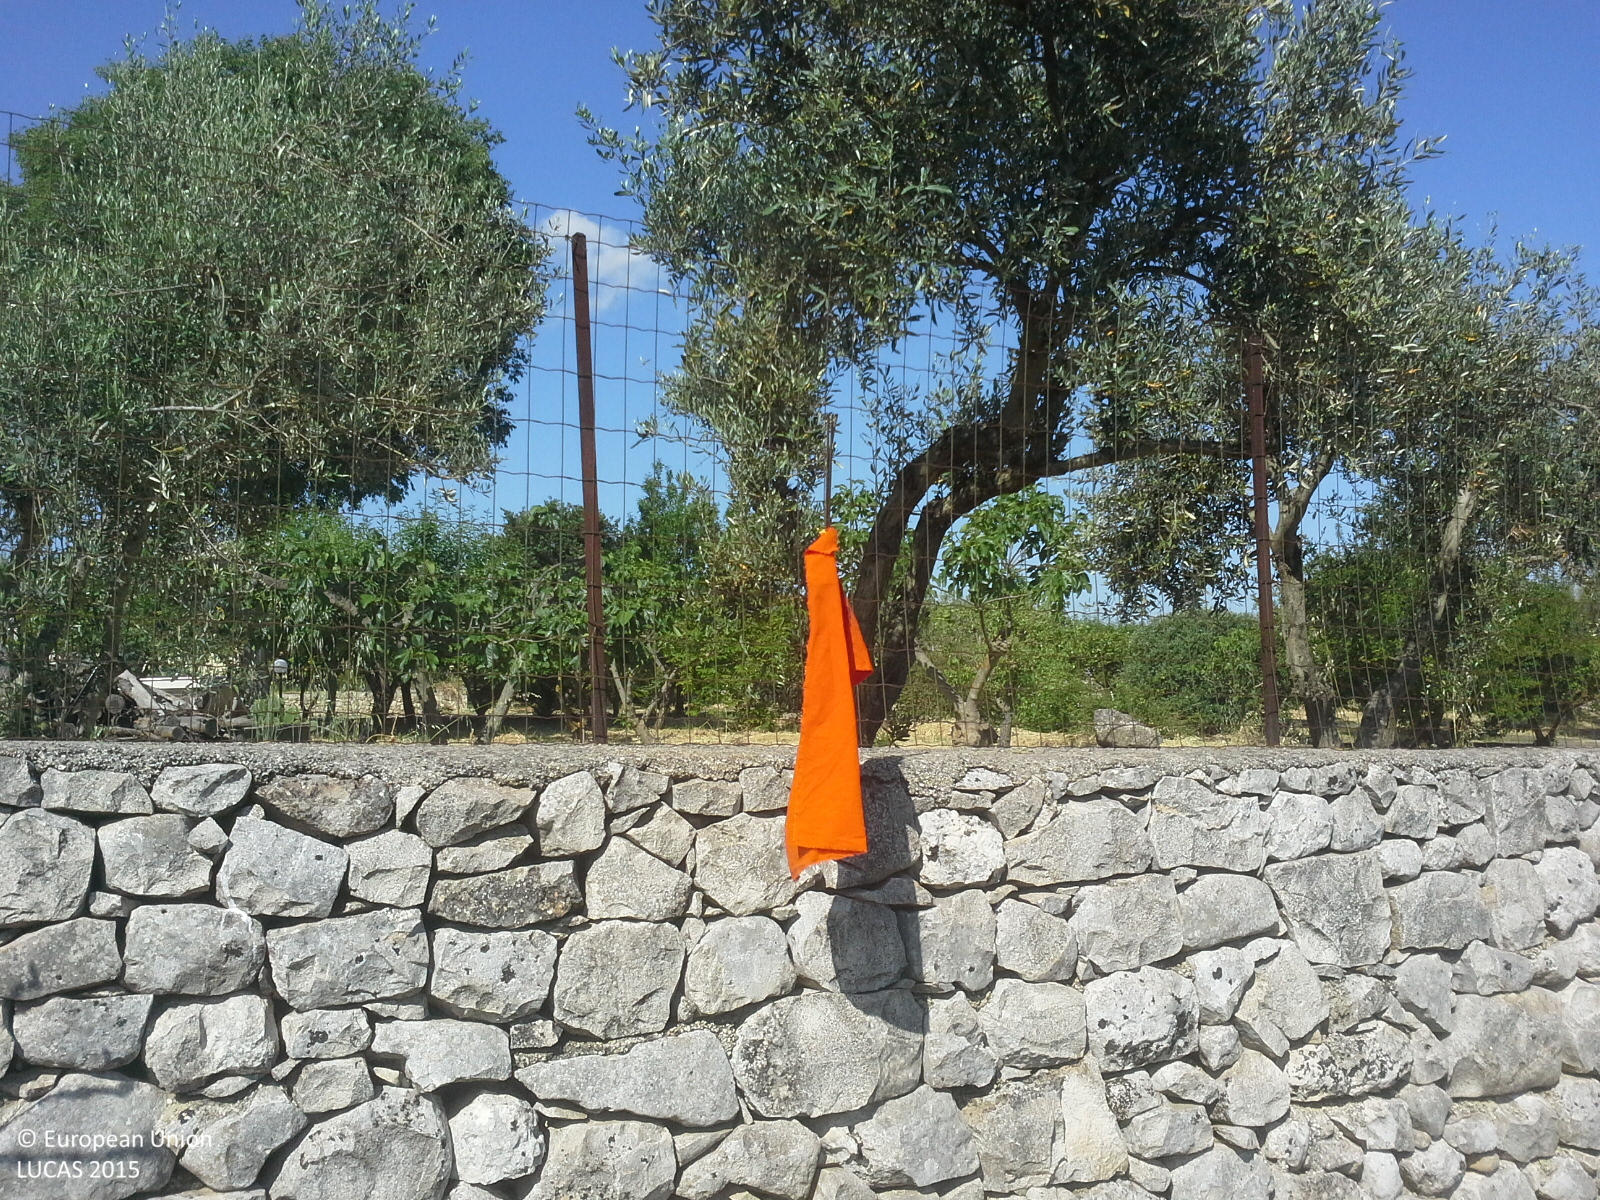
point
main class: Cropland
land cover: Olive groves
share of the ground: > 75 %
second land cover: Spontaneously vegetated surfaces
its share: > 75 %
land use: Agriculture (excluding fallow land and kitchen gardens)
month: May
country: IT
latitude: 36.8274
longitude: 14.7715
